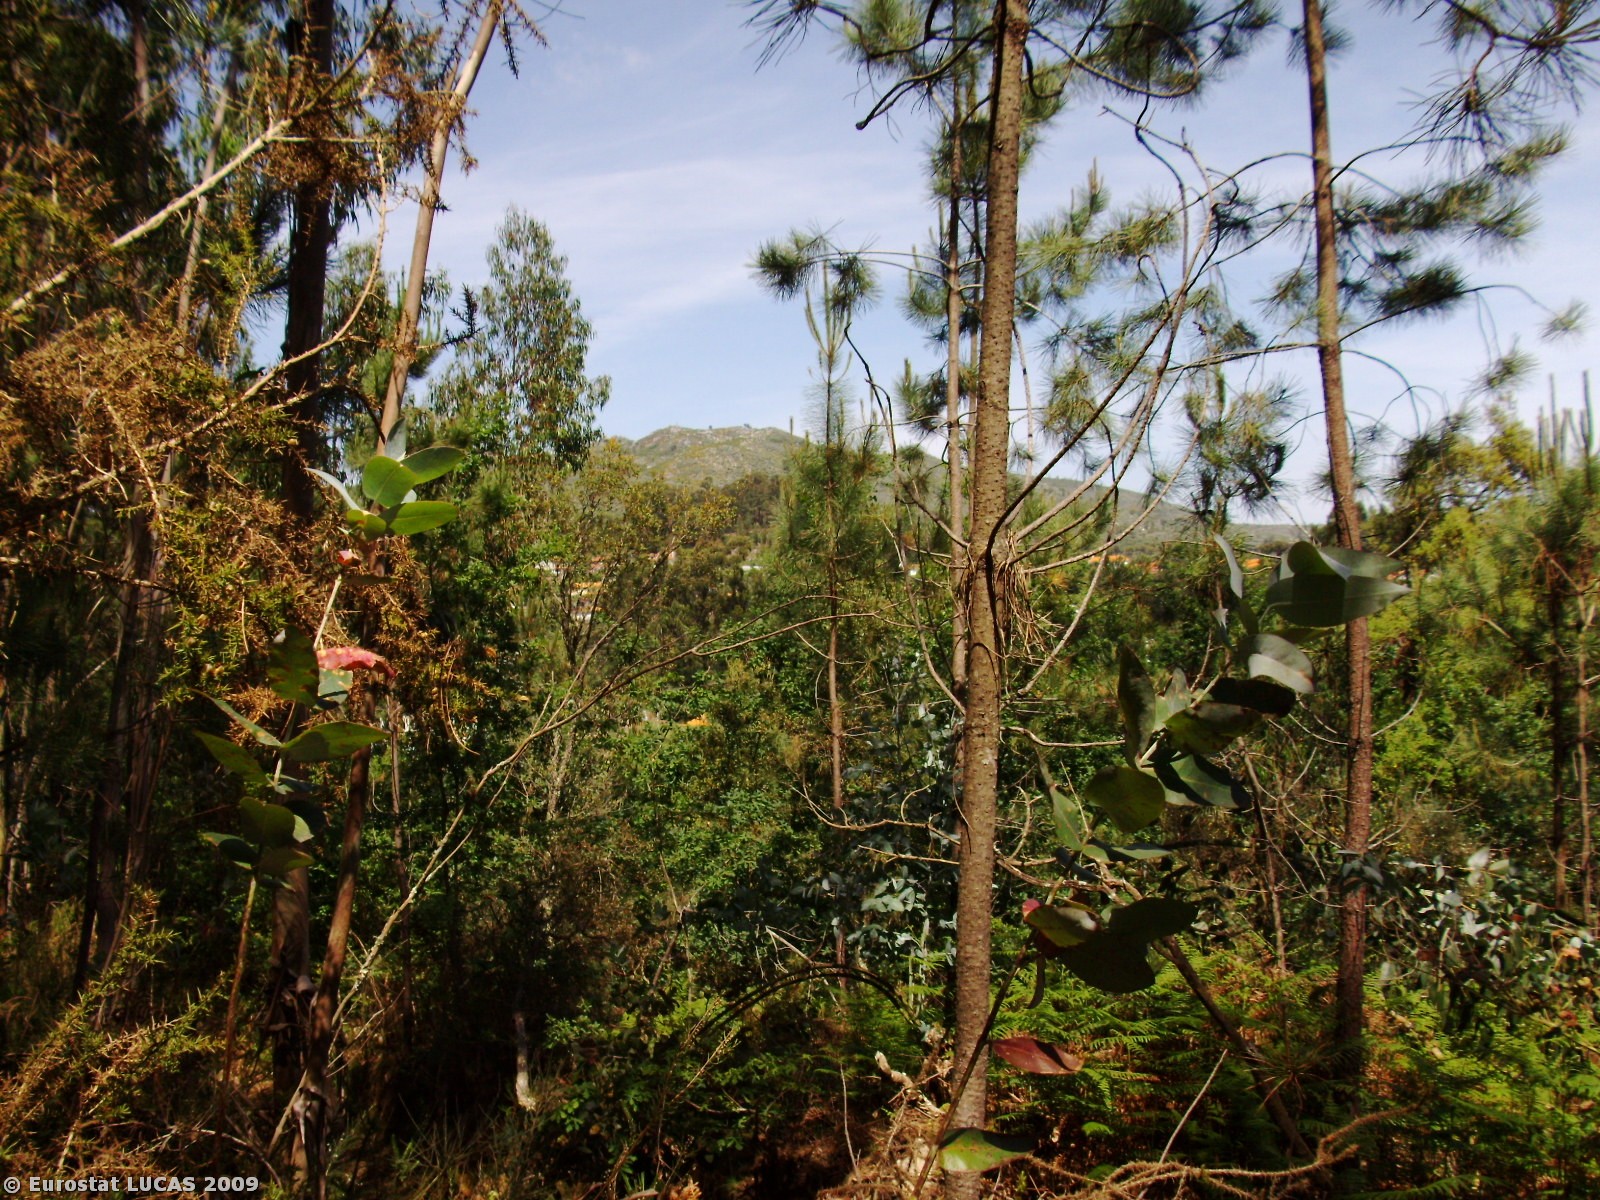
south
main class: Woodland
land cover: Broadleaved woodland
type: plantations and self-sown exotic forest
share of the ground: 50 - 75 %
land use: Forestry
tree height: > 5 m
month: May
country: PT
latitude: 41.6843
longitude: -8.6270
